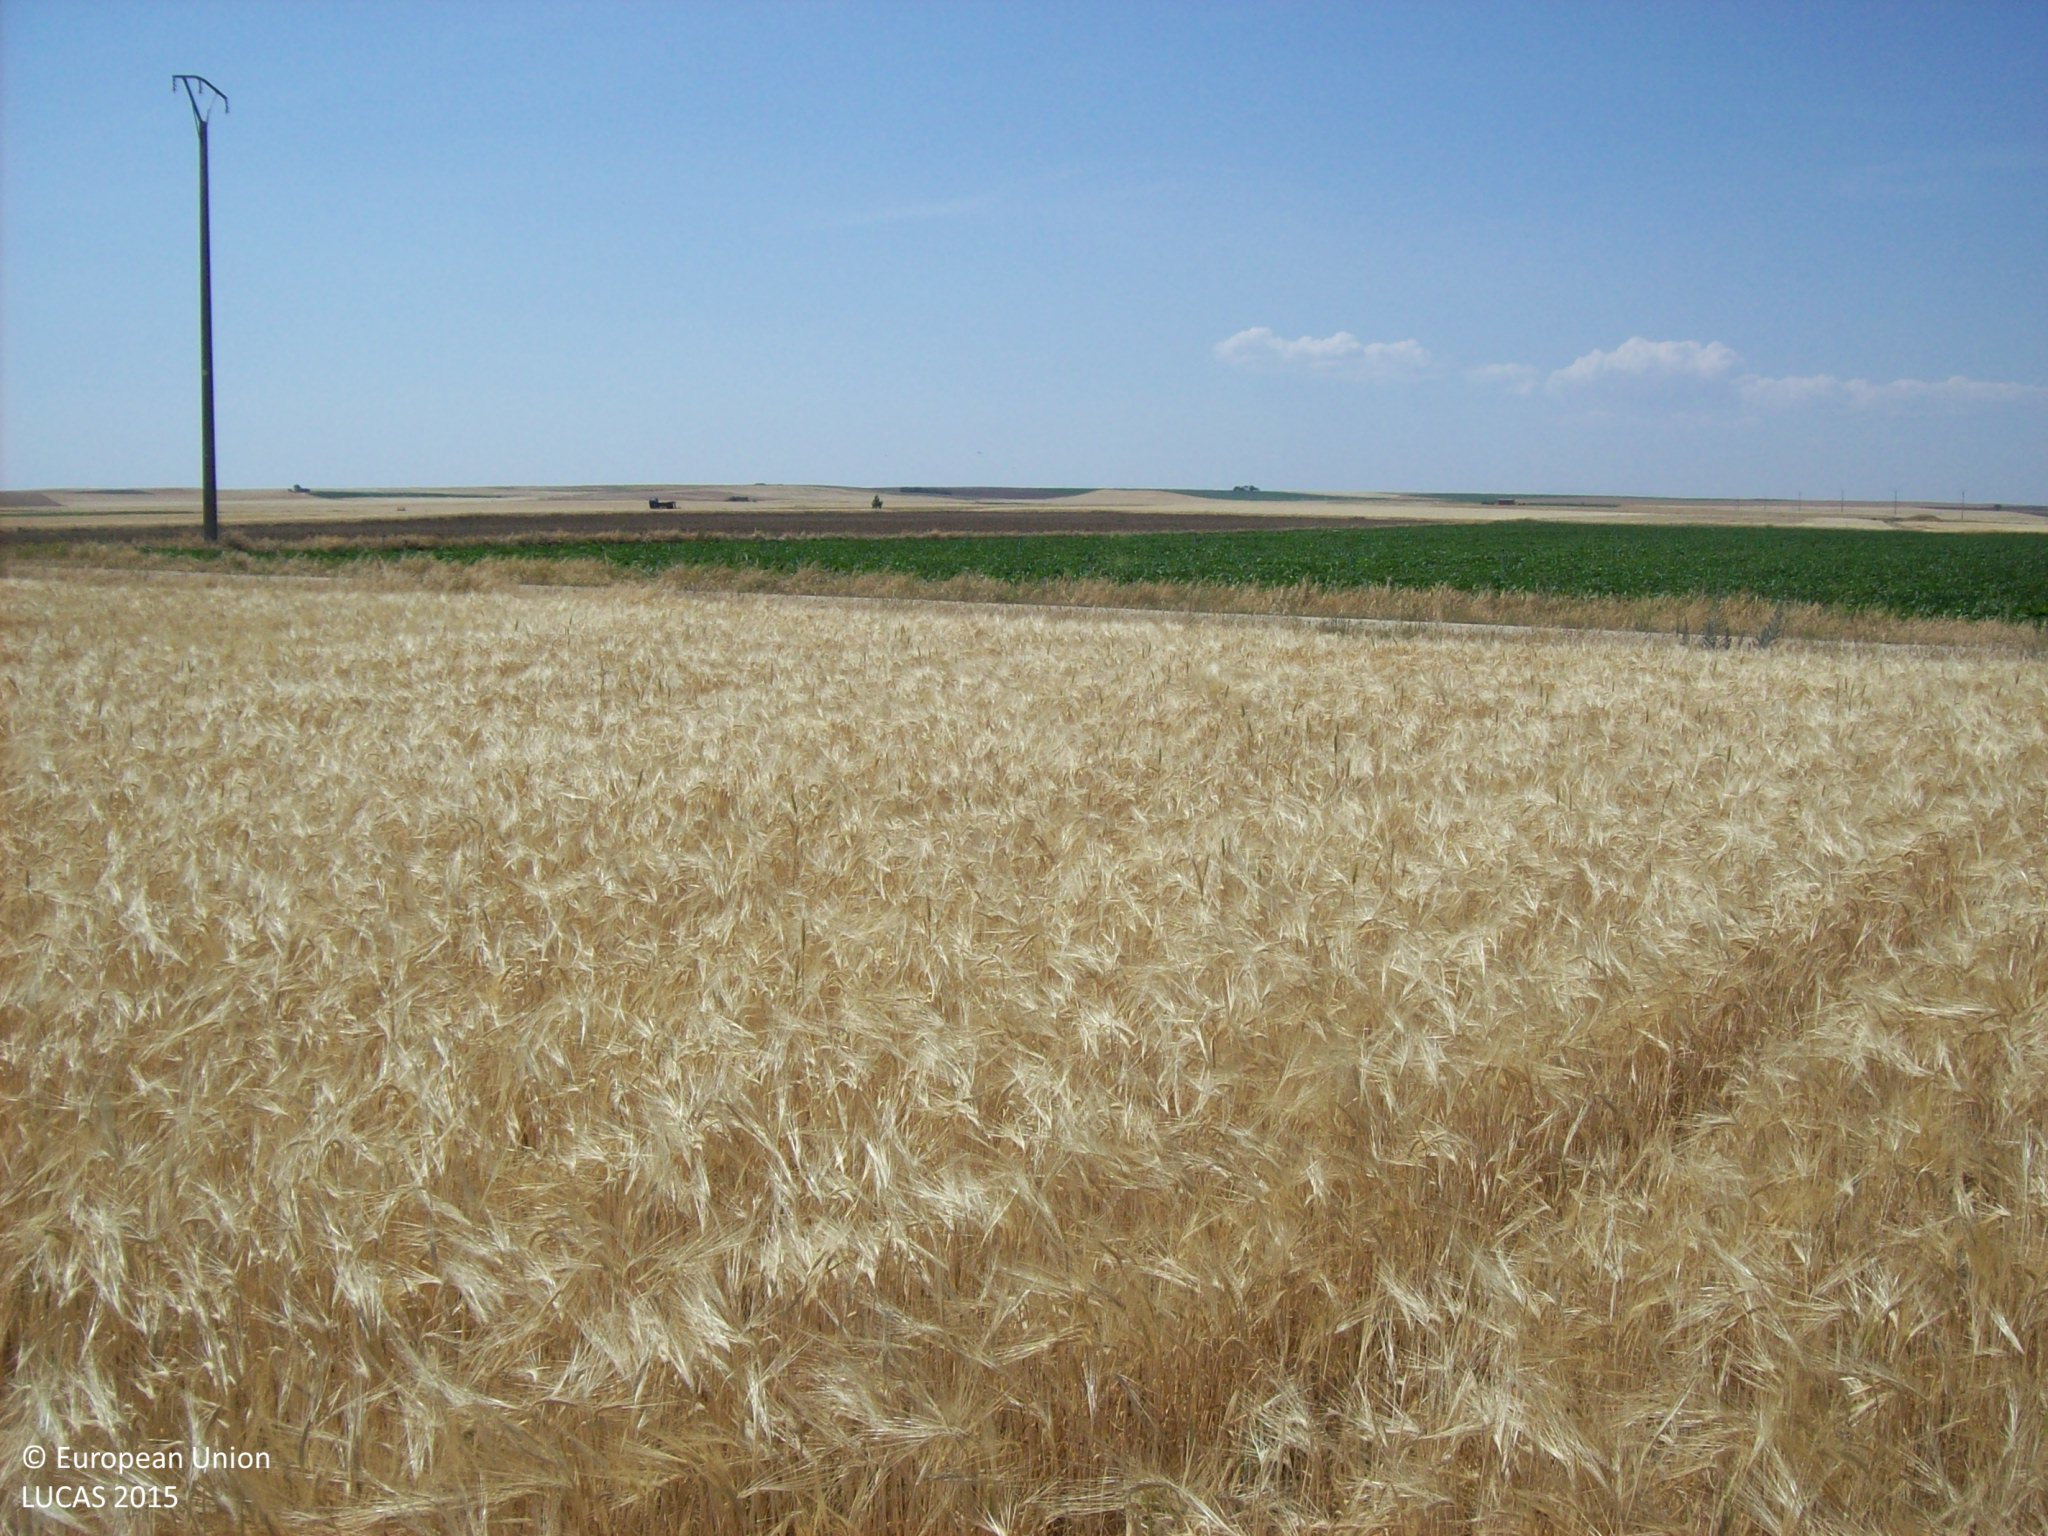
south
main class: Cropland
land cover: Barley
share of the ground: > 75 %
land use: Agriculture (excluding fallow land and kitchen gardens)
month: June
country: ES
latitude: 41.2050
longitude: -5.0839
